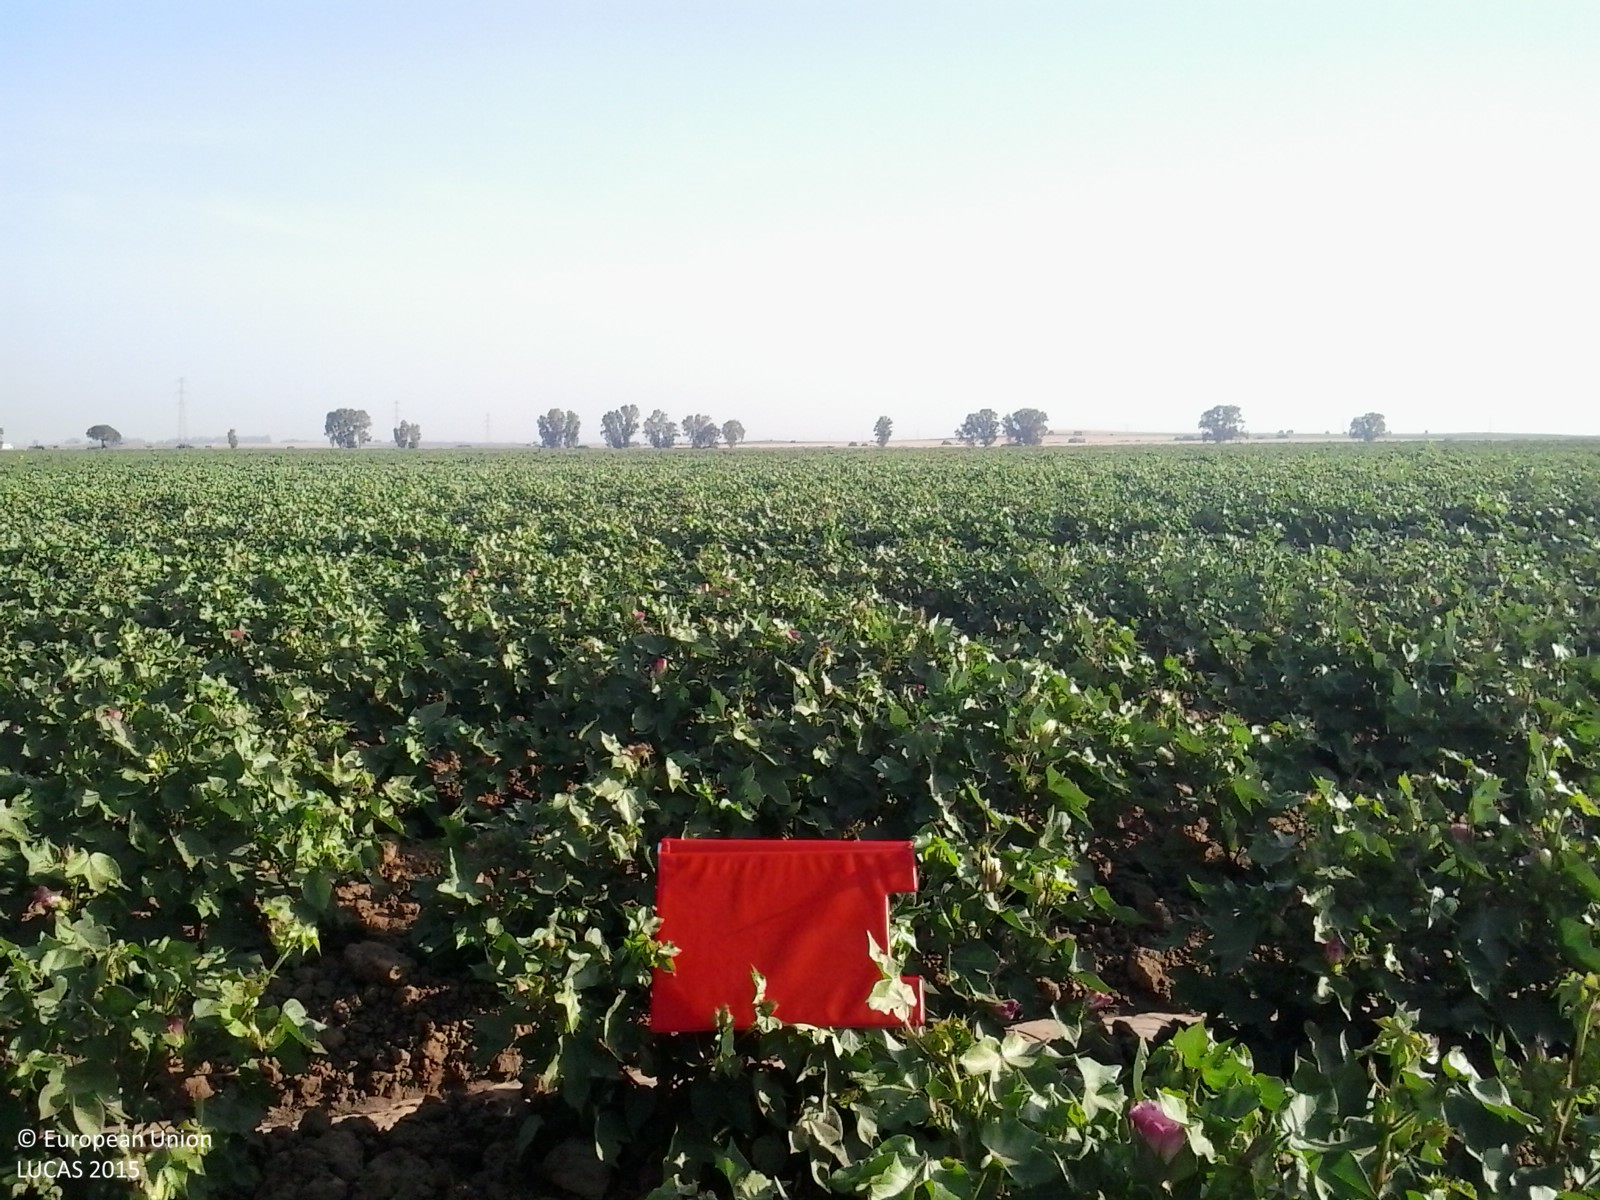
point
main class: Cropland
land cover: Cotton
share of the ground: 25 - 50 %
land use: Agriculture (excluding fallow land and kitchen gardens)
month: July
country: ES
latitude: 37.0958
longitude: -5.8232
